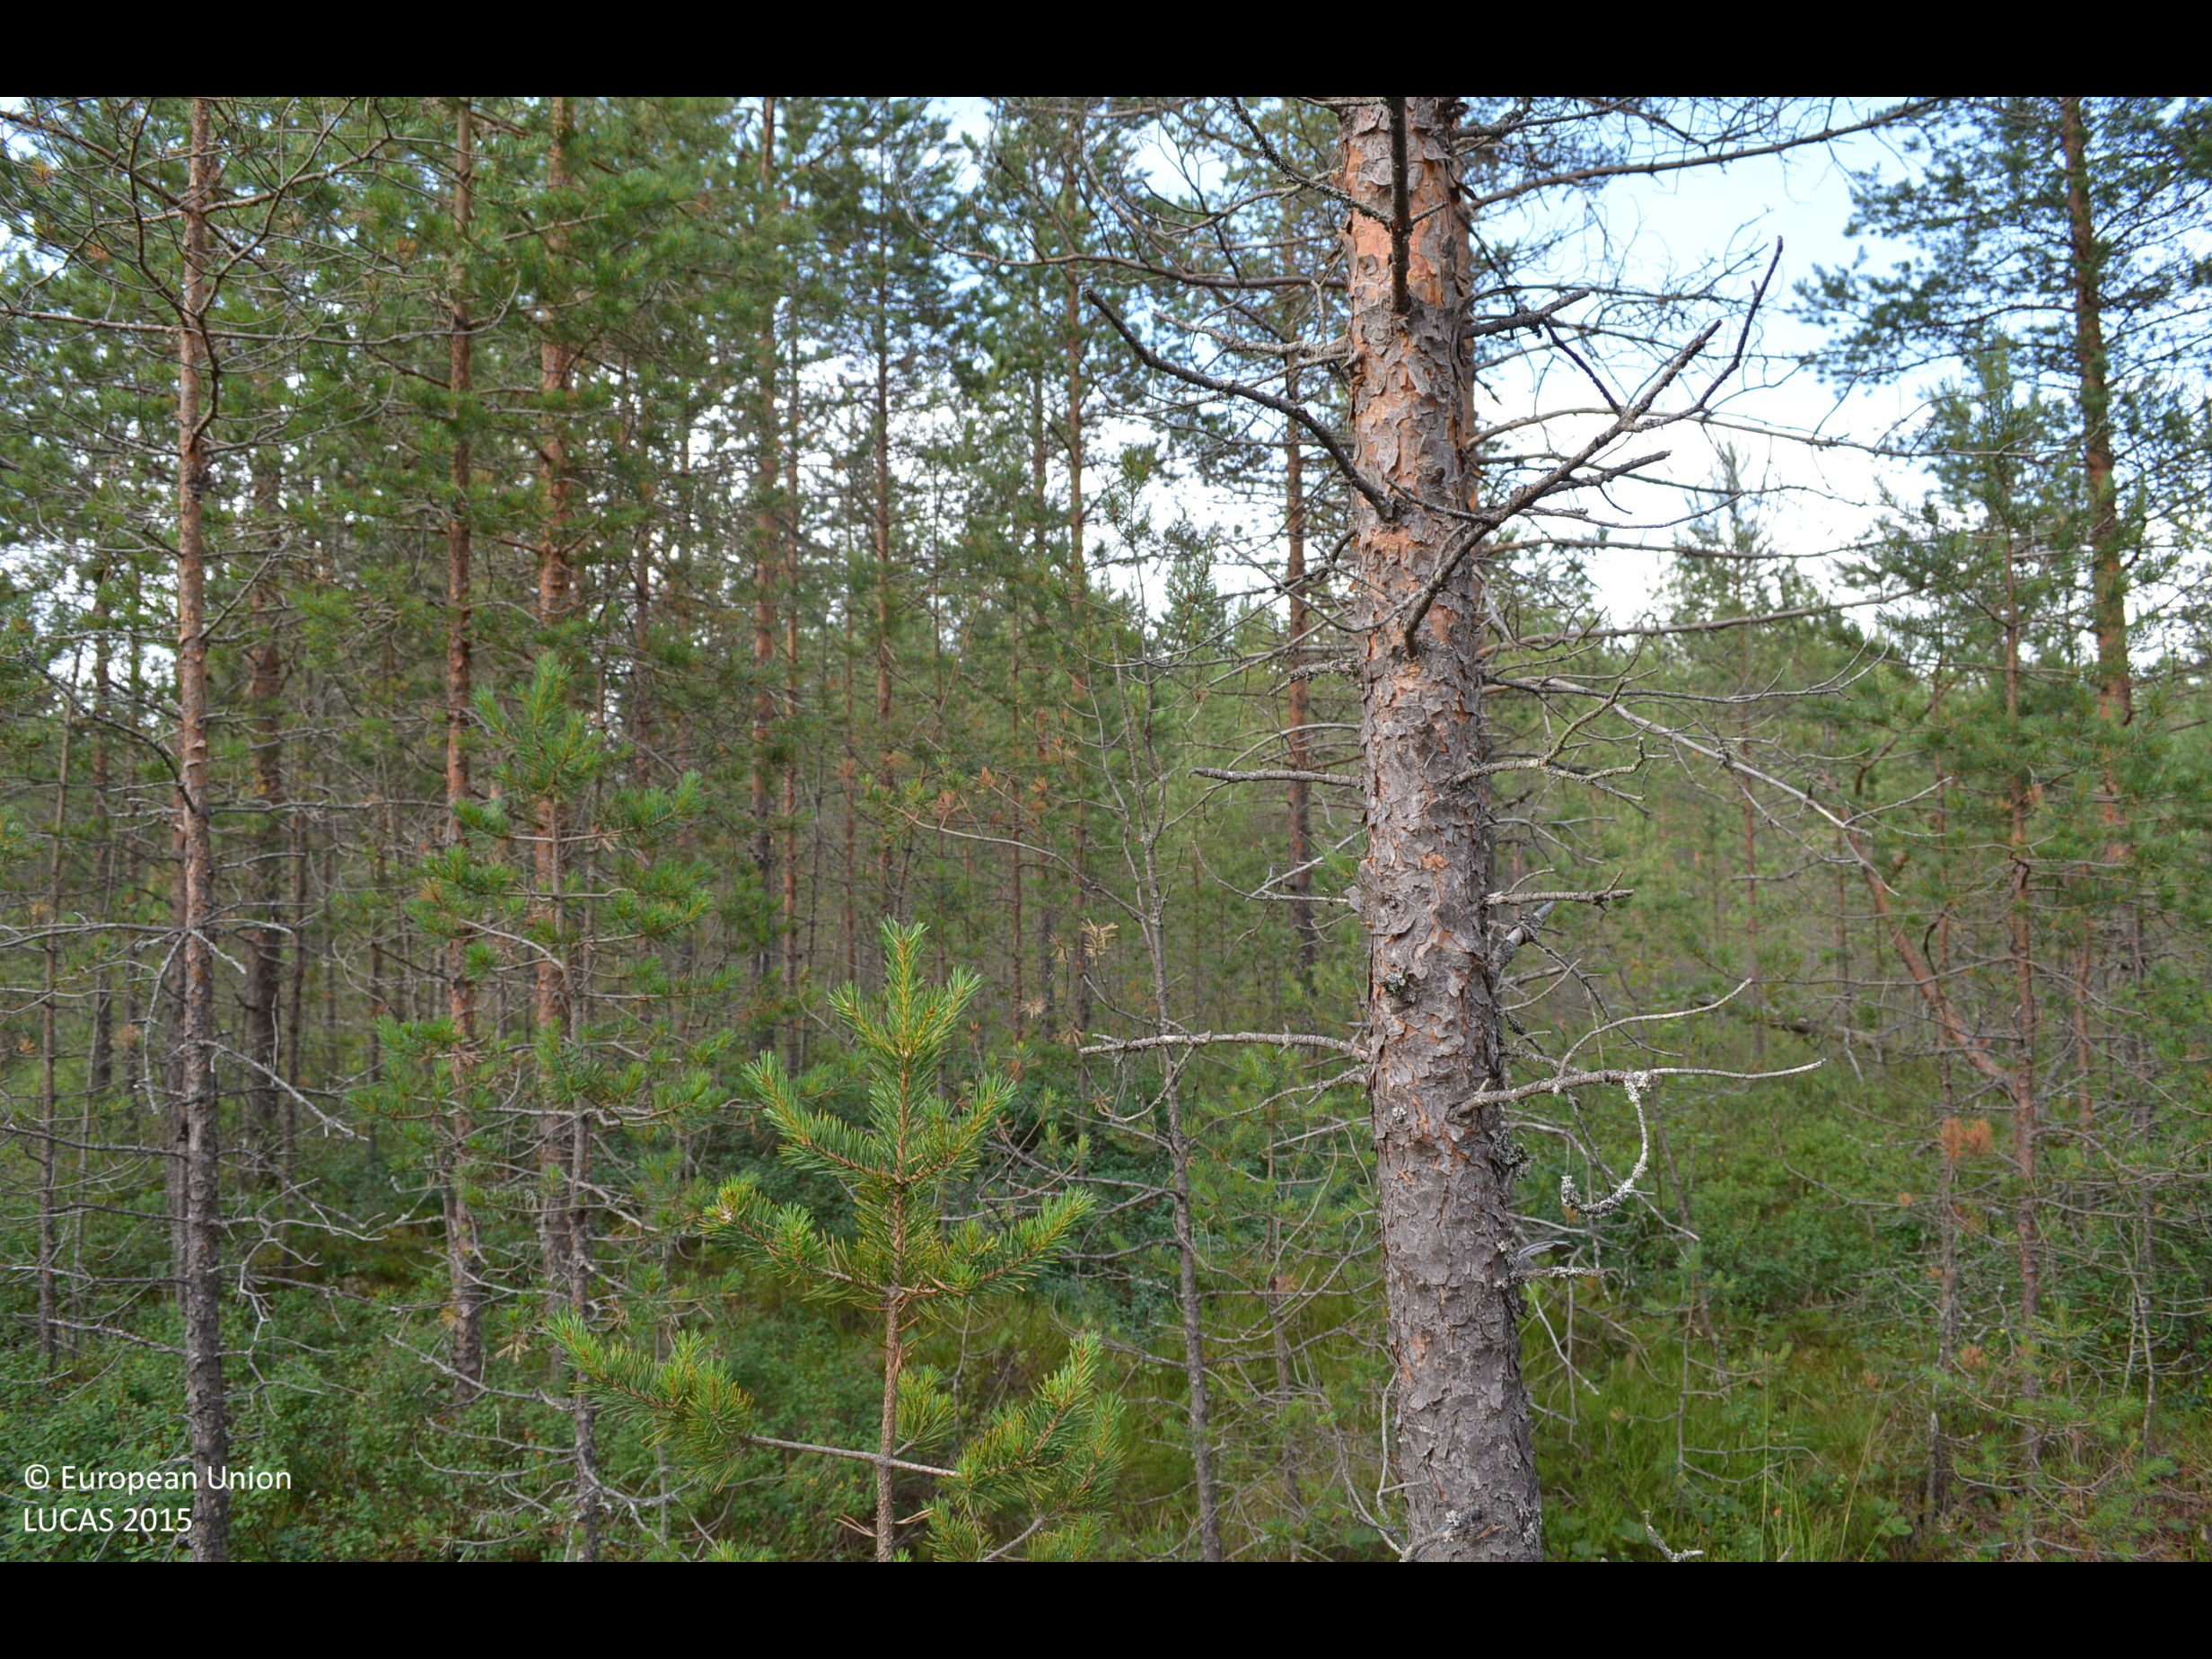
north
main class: Woodland
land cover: Pine dominated coniferous woodland
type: boreal forest
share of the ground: > 75 %
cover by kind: coniferous forest trees 75 %, shrubs 25 %
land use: Forestry
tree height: < 5 m
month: July
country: FI
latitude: 62.1943
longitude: 23.3887
